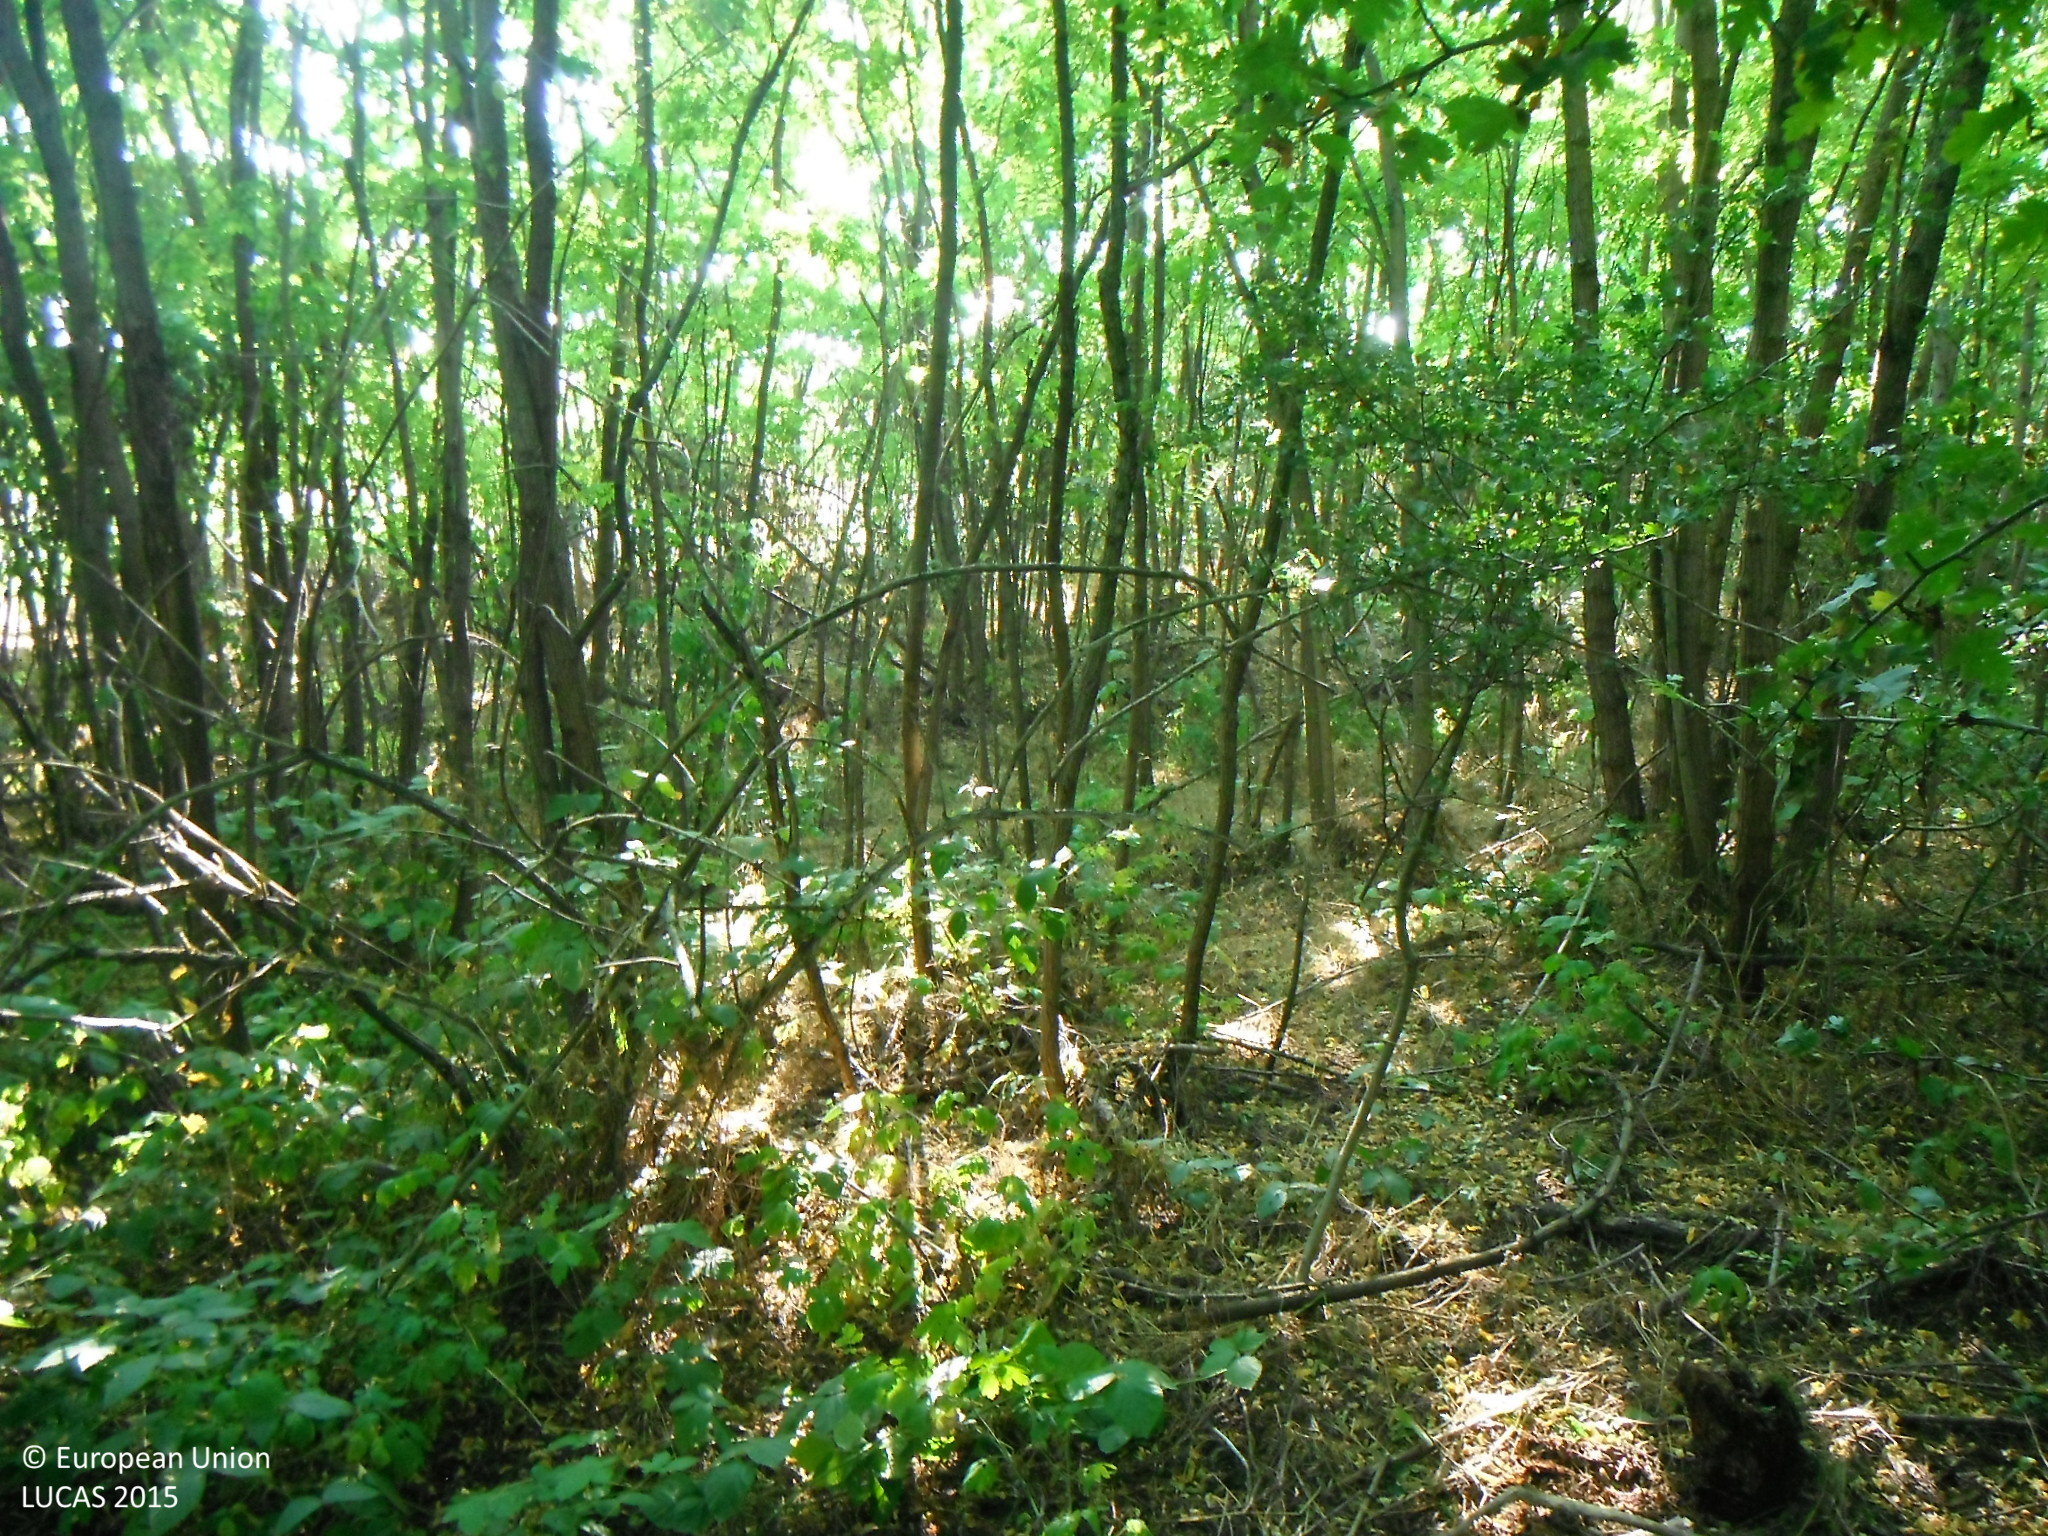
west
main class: Woodland
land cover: Broadleaved woodland
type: exotic forest
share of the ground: > 75 %
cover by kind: broadleaved forest trees 90 %, shrubs 10 %
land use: Forestry
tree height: > 5 m
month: July
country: SK
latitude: 48.1392
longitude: 19.2811
